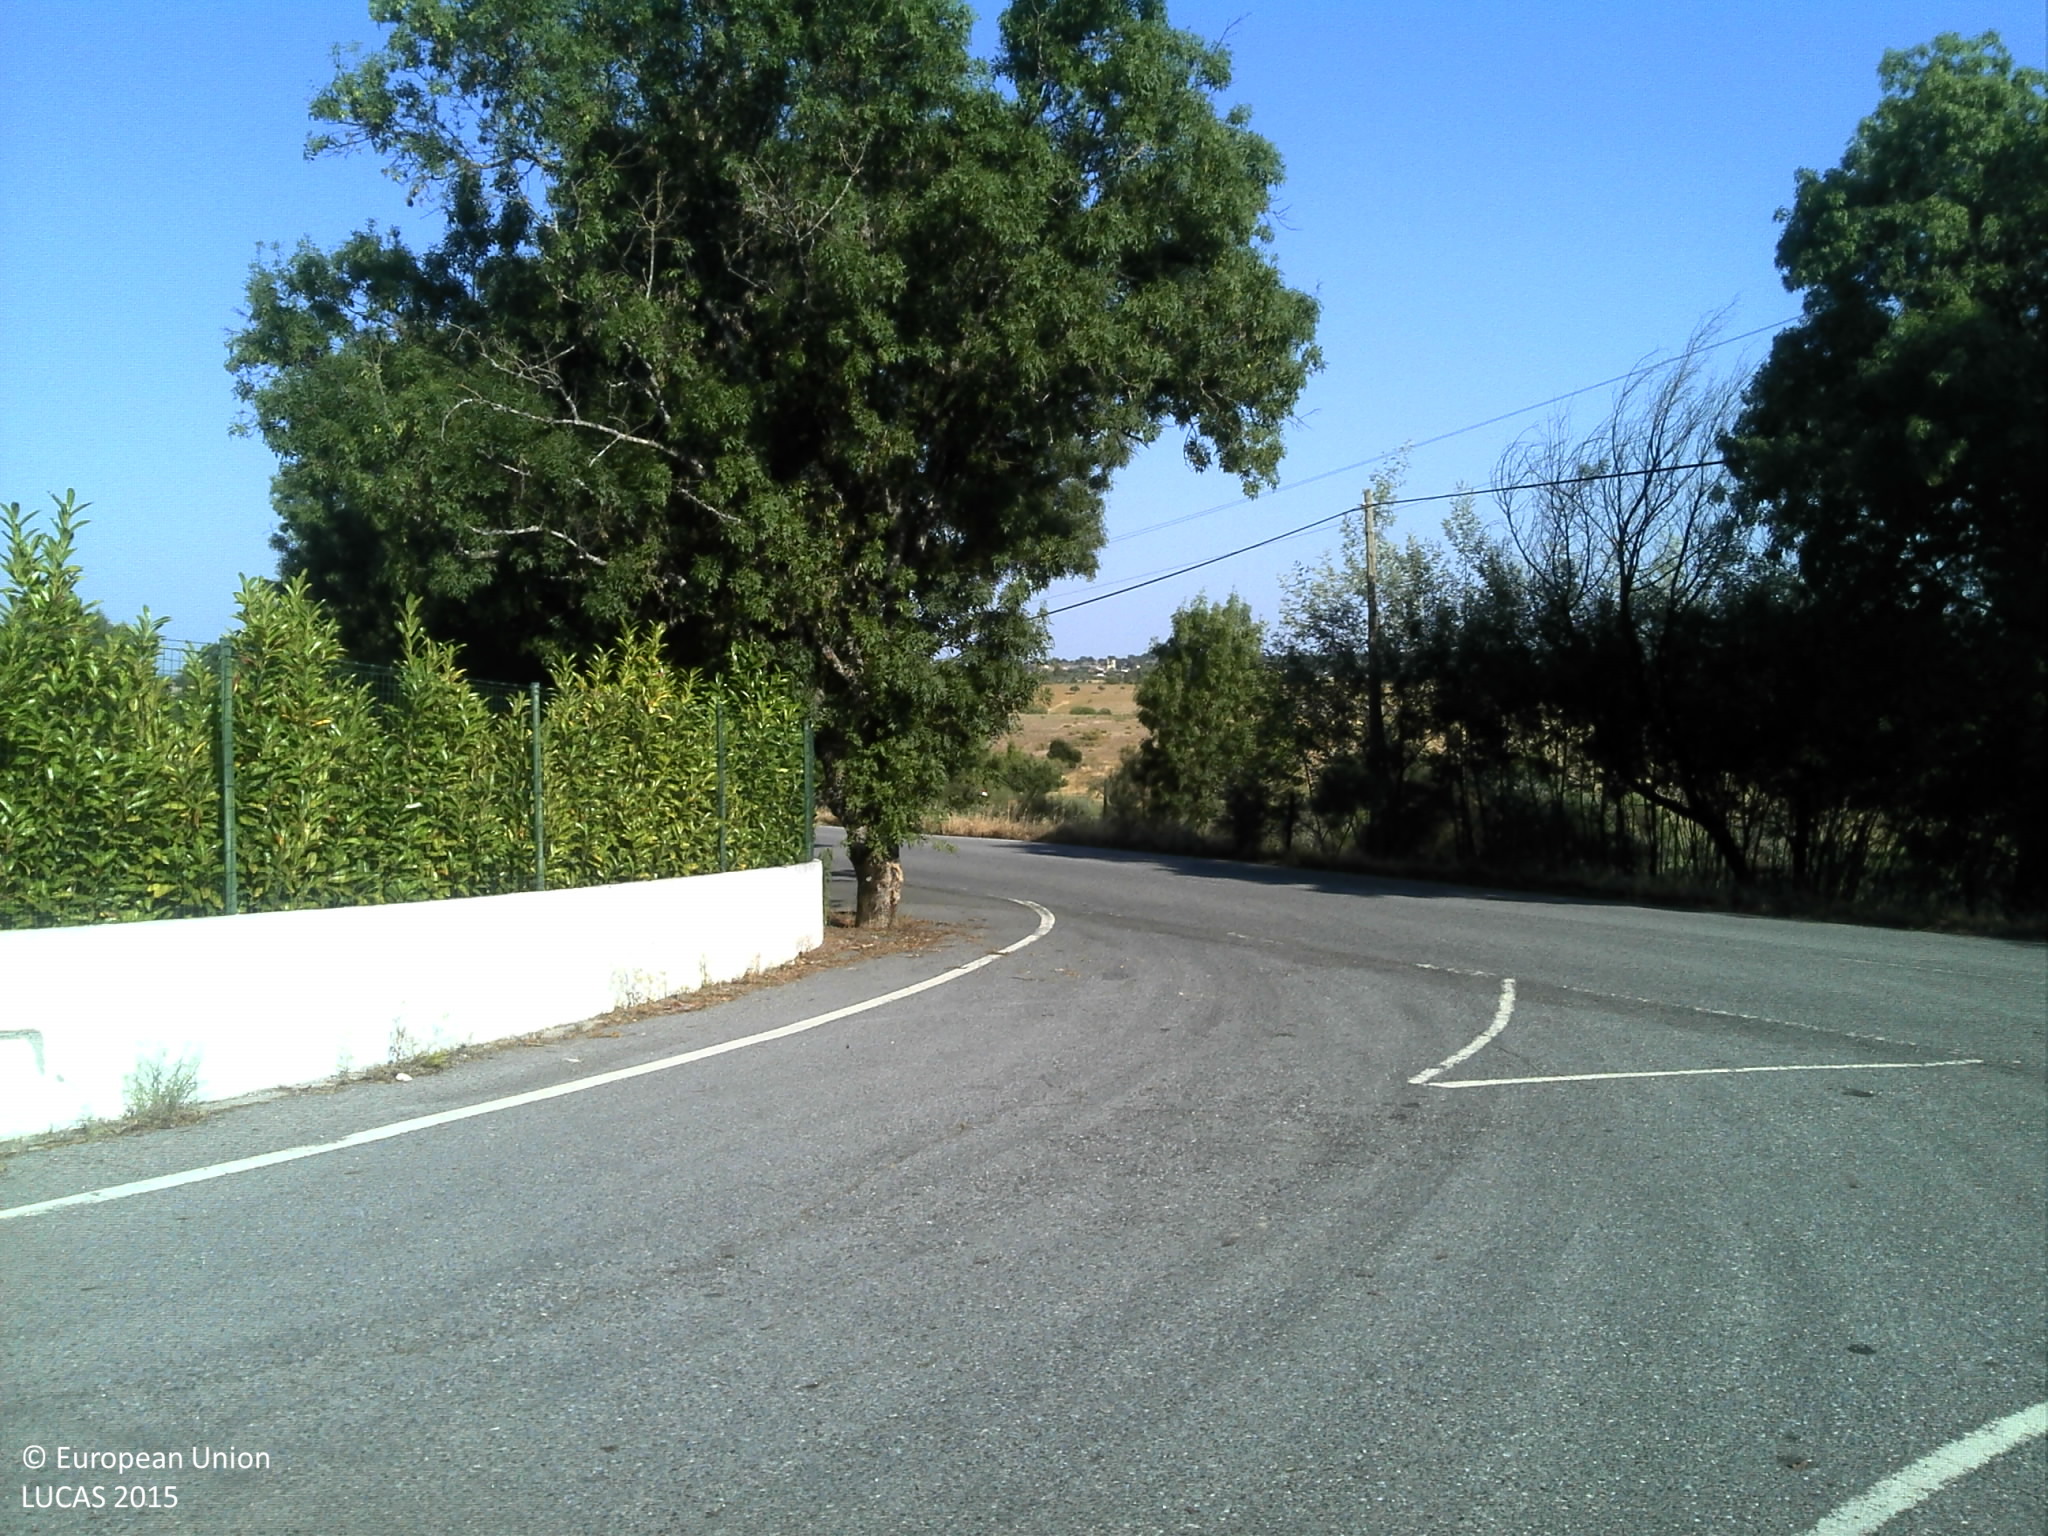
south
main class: Woodland
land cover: Broadleaved woodland
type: broadleaved evergreen forest
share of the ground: 25 - 50 %
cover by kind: broadleaved forest trees 40 %, unconsolidated bare surface 40 %, herbaceous plants 20 %
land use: Forestry
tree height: > 5 m
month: June
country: PT
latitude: 39.9519
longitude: -7.4111
